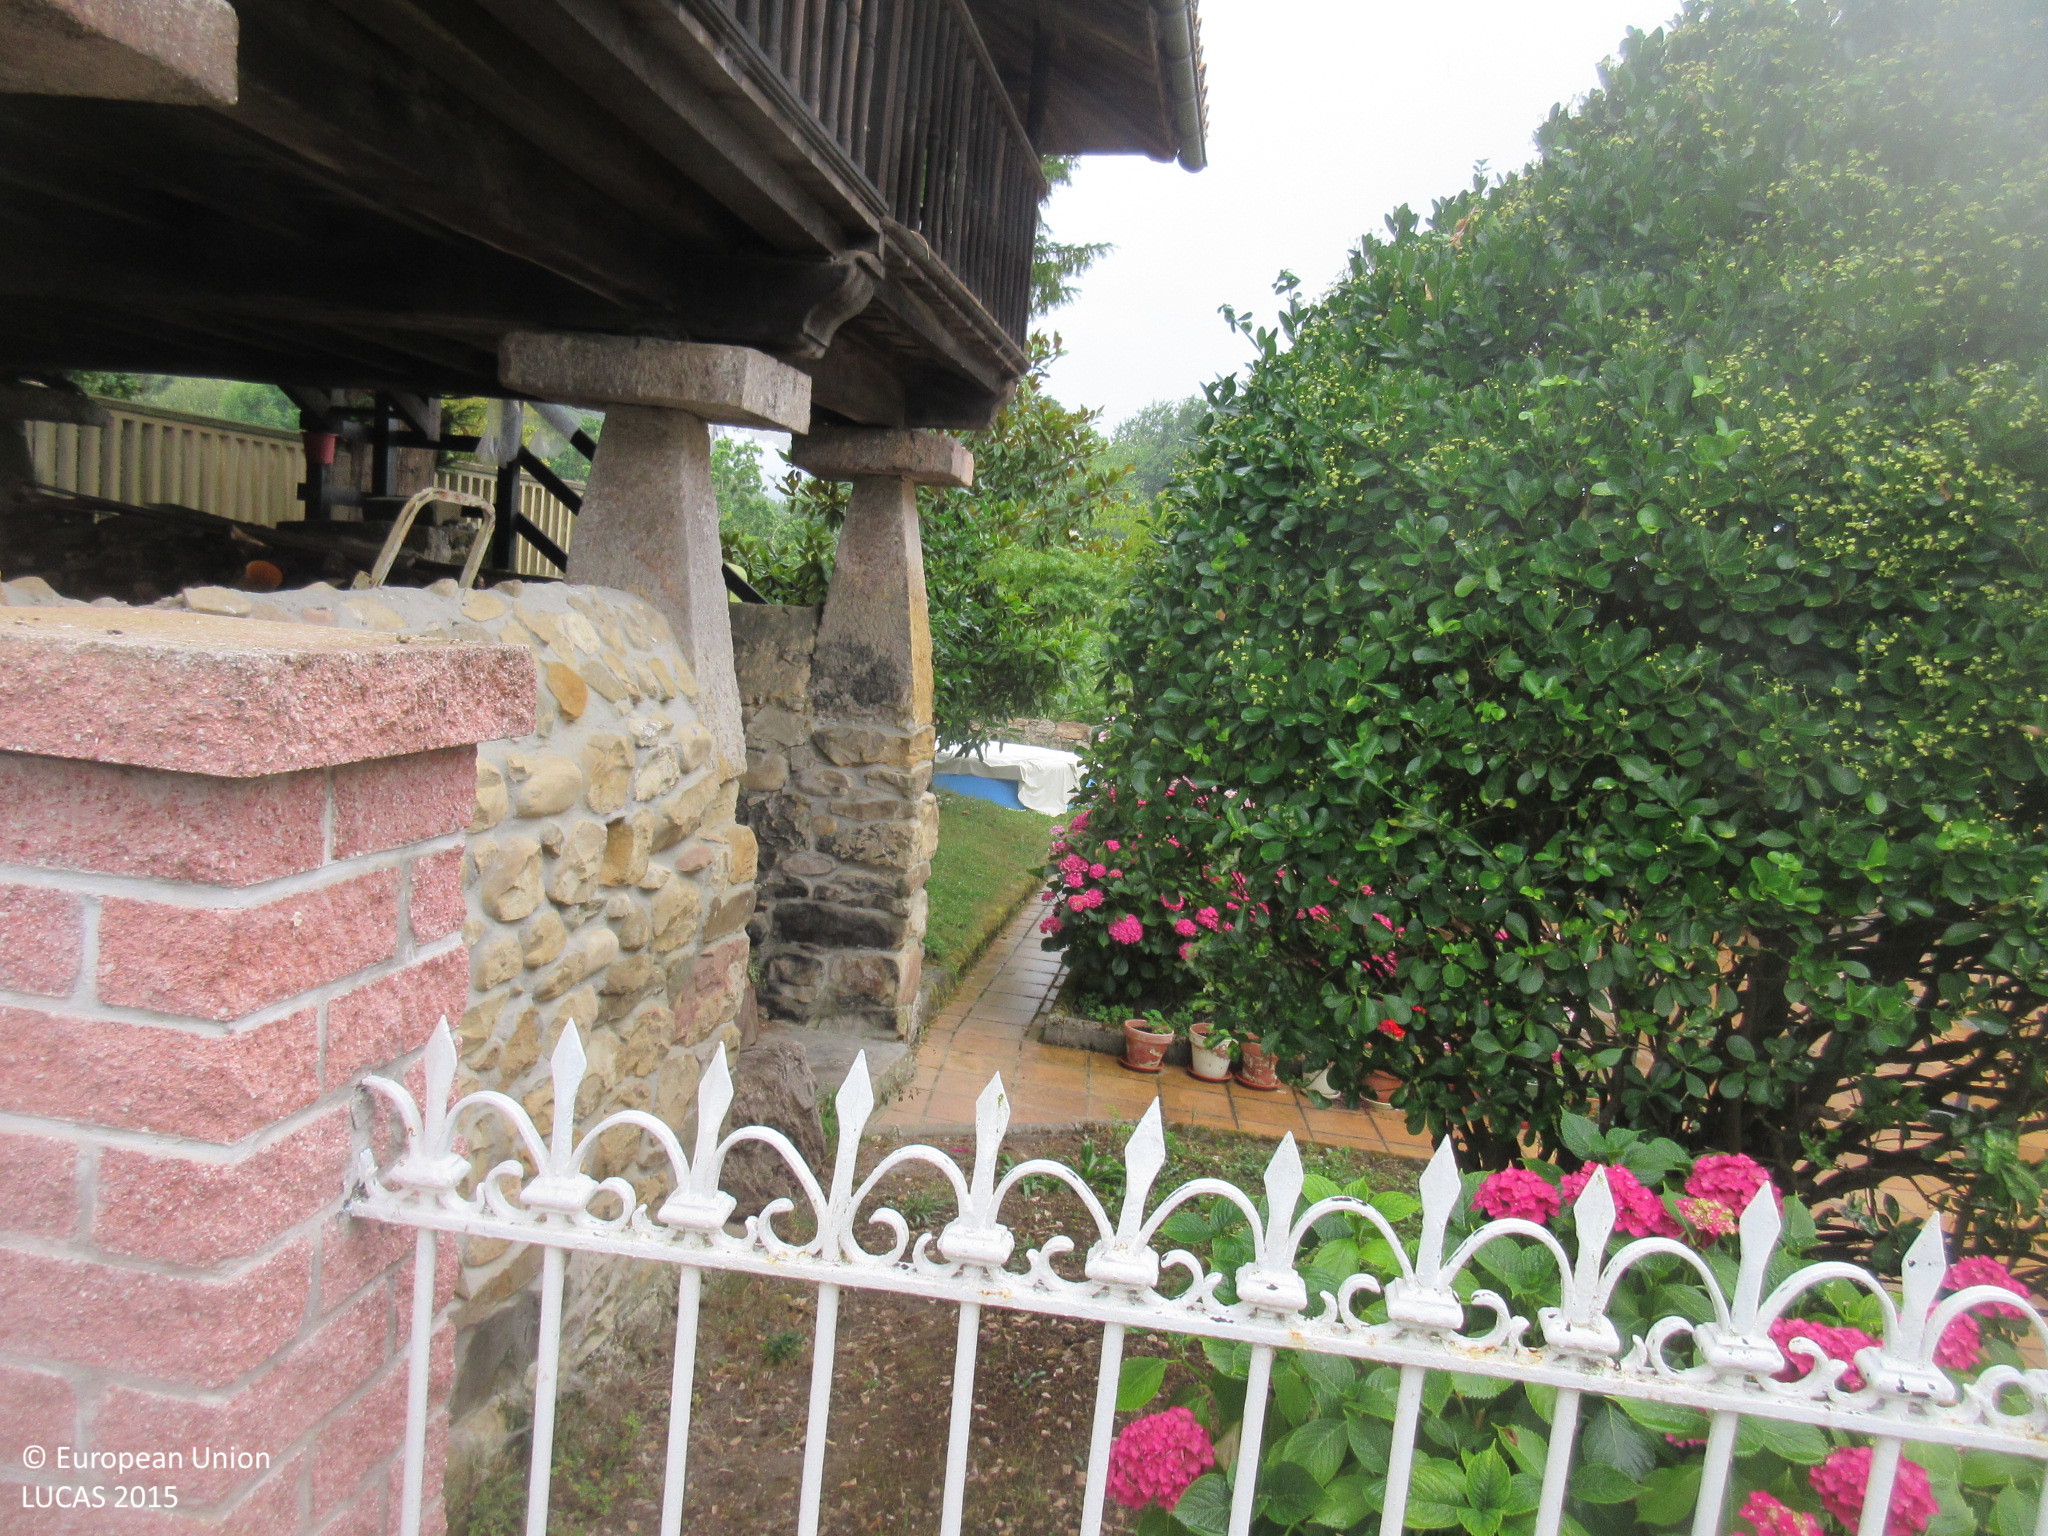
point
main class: Grassland
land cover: Grassland with sparse tree/shrub cover
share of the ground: > 75 %
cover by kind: herbaceous plants 95 %, broadleaved forest trees 5 %
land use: Residential
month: July
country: ES
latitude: 43.3600
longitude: -5.2644
